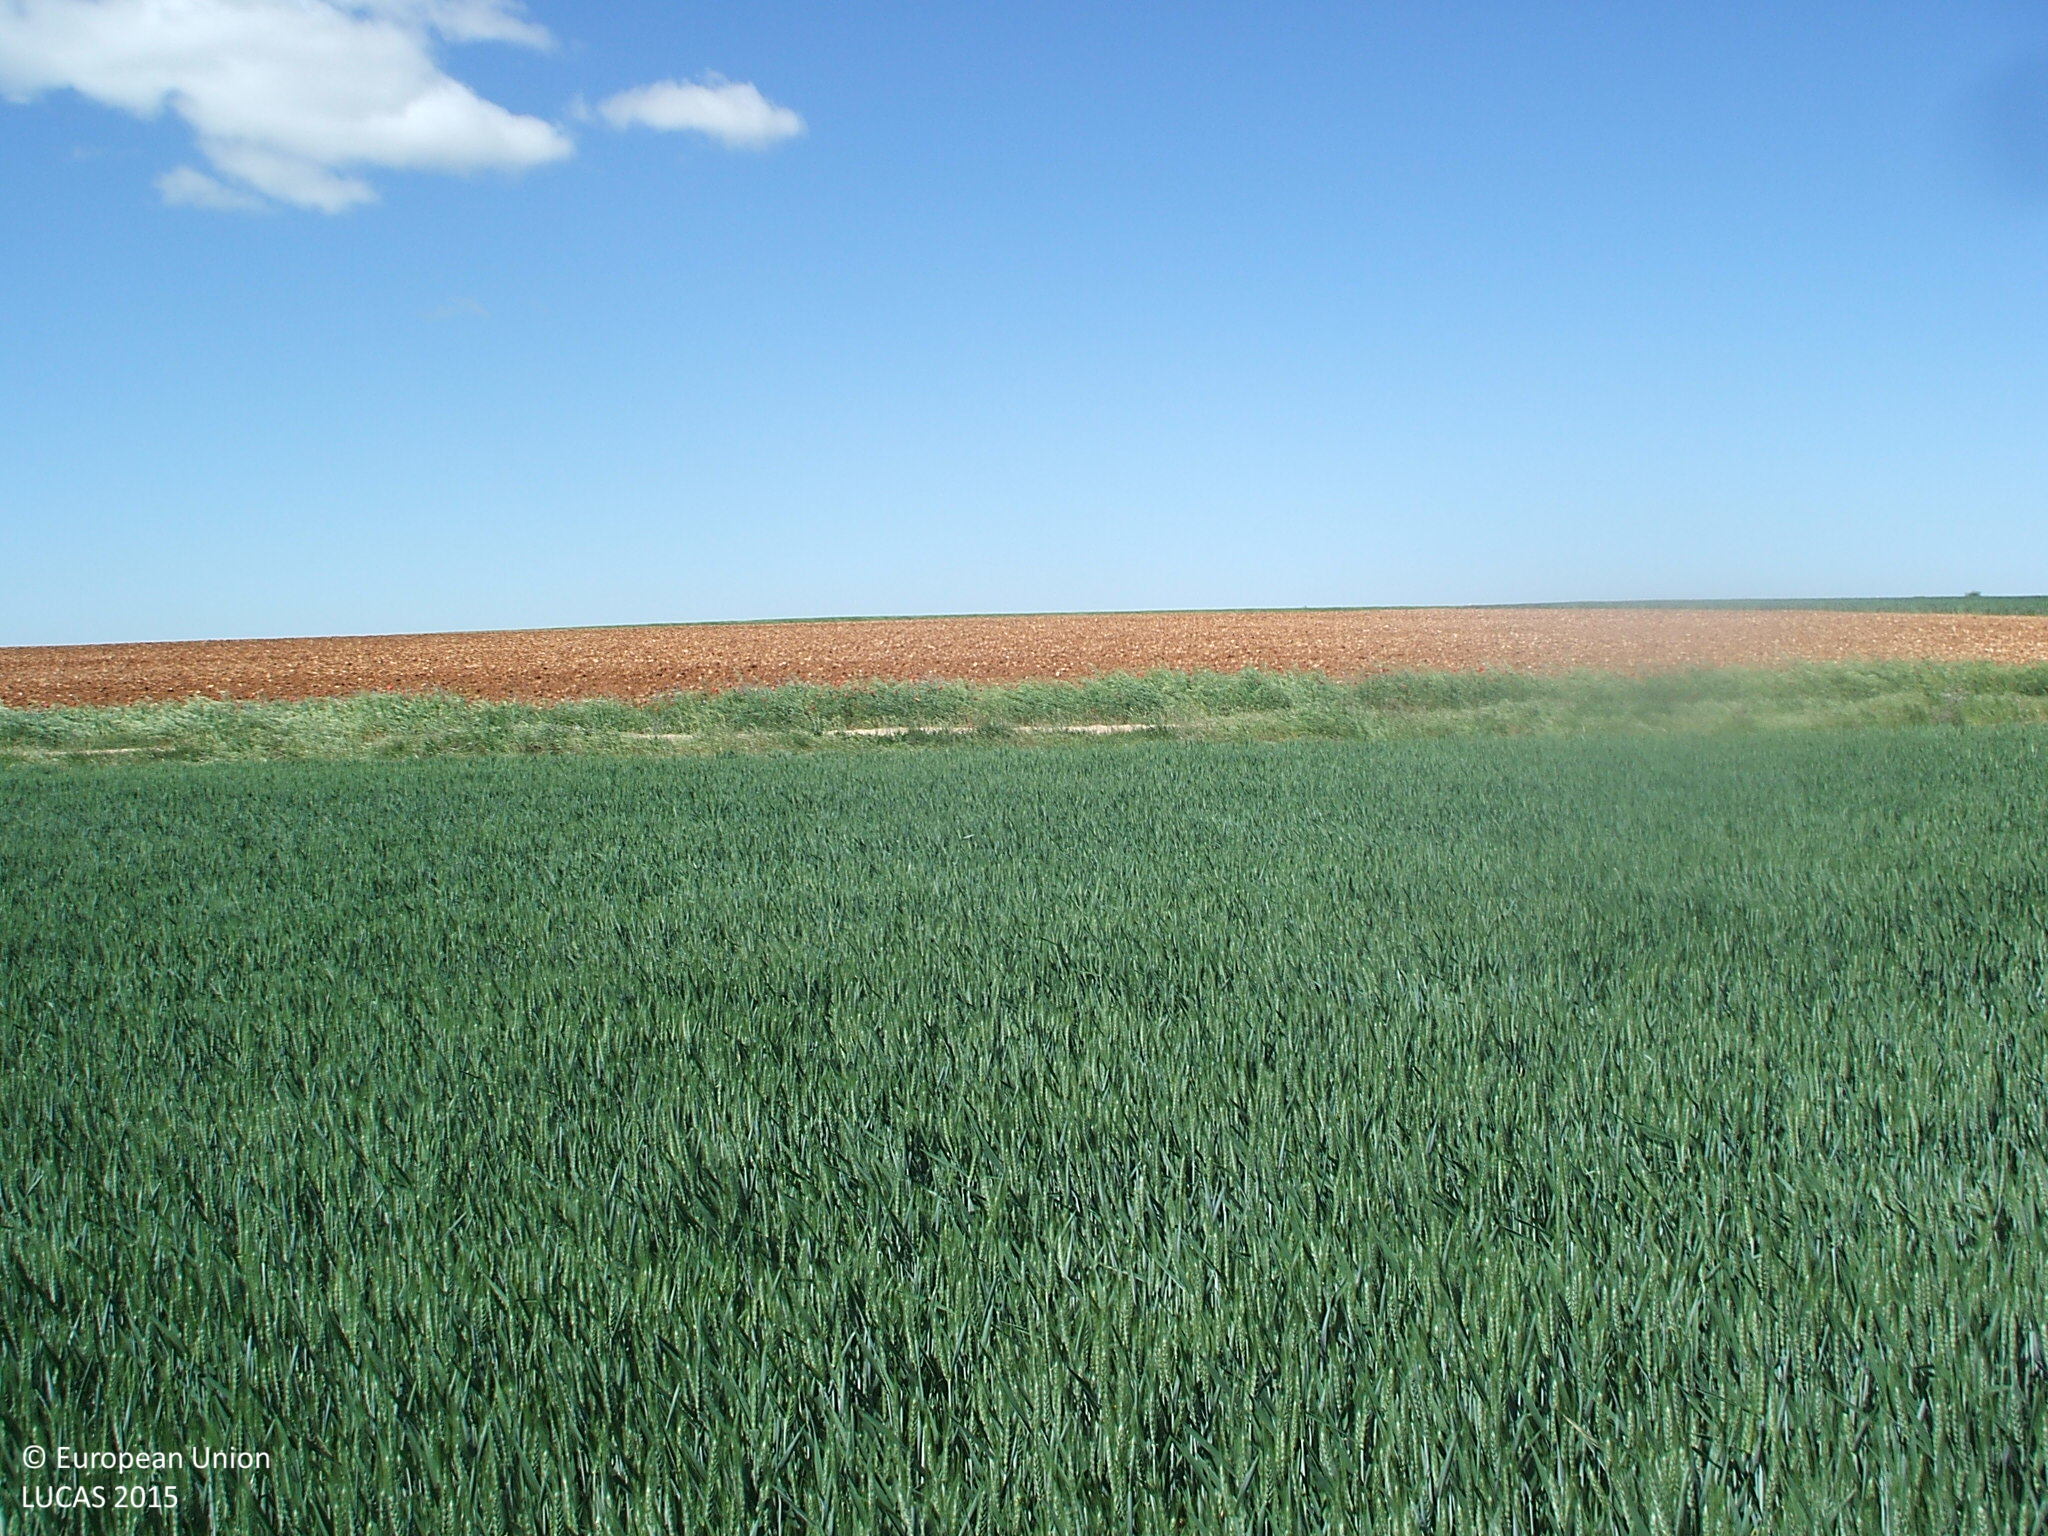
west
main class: Cropland
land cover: Common wheat
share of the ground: > 75 %
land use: Agriculture (excluding fallow land and kitchen gardens)
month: May
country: ES
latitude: 40.8771
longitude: -2.8844
